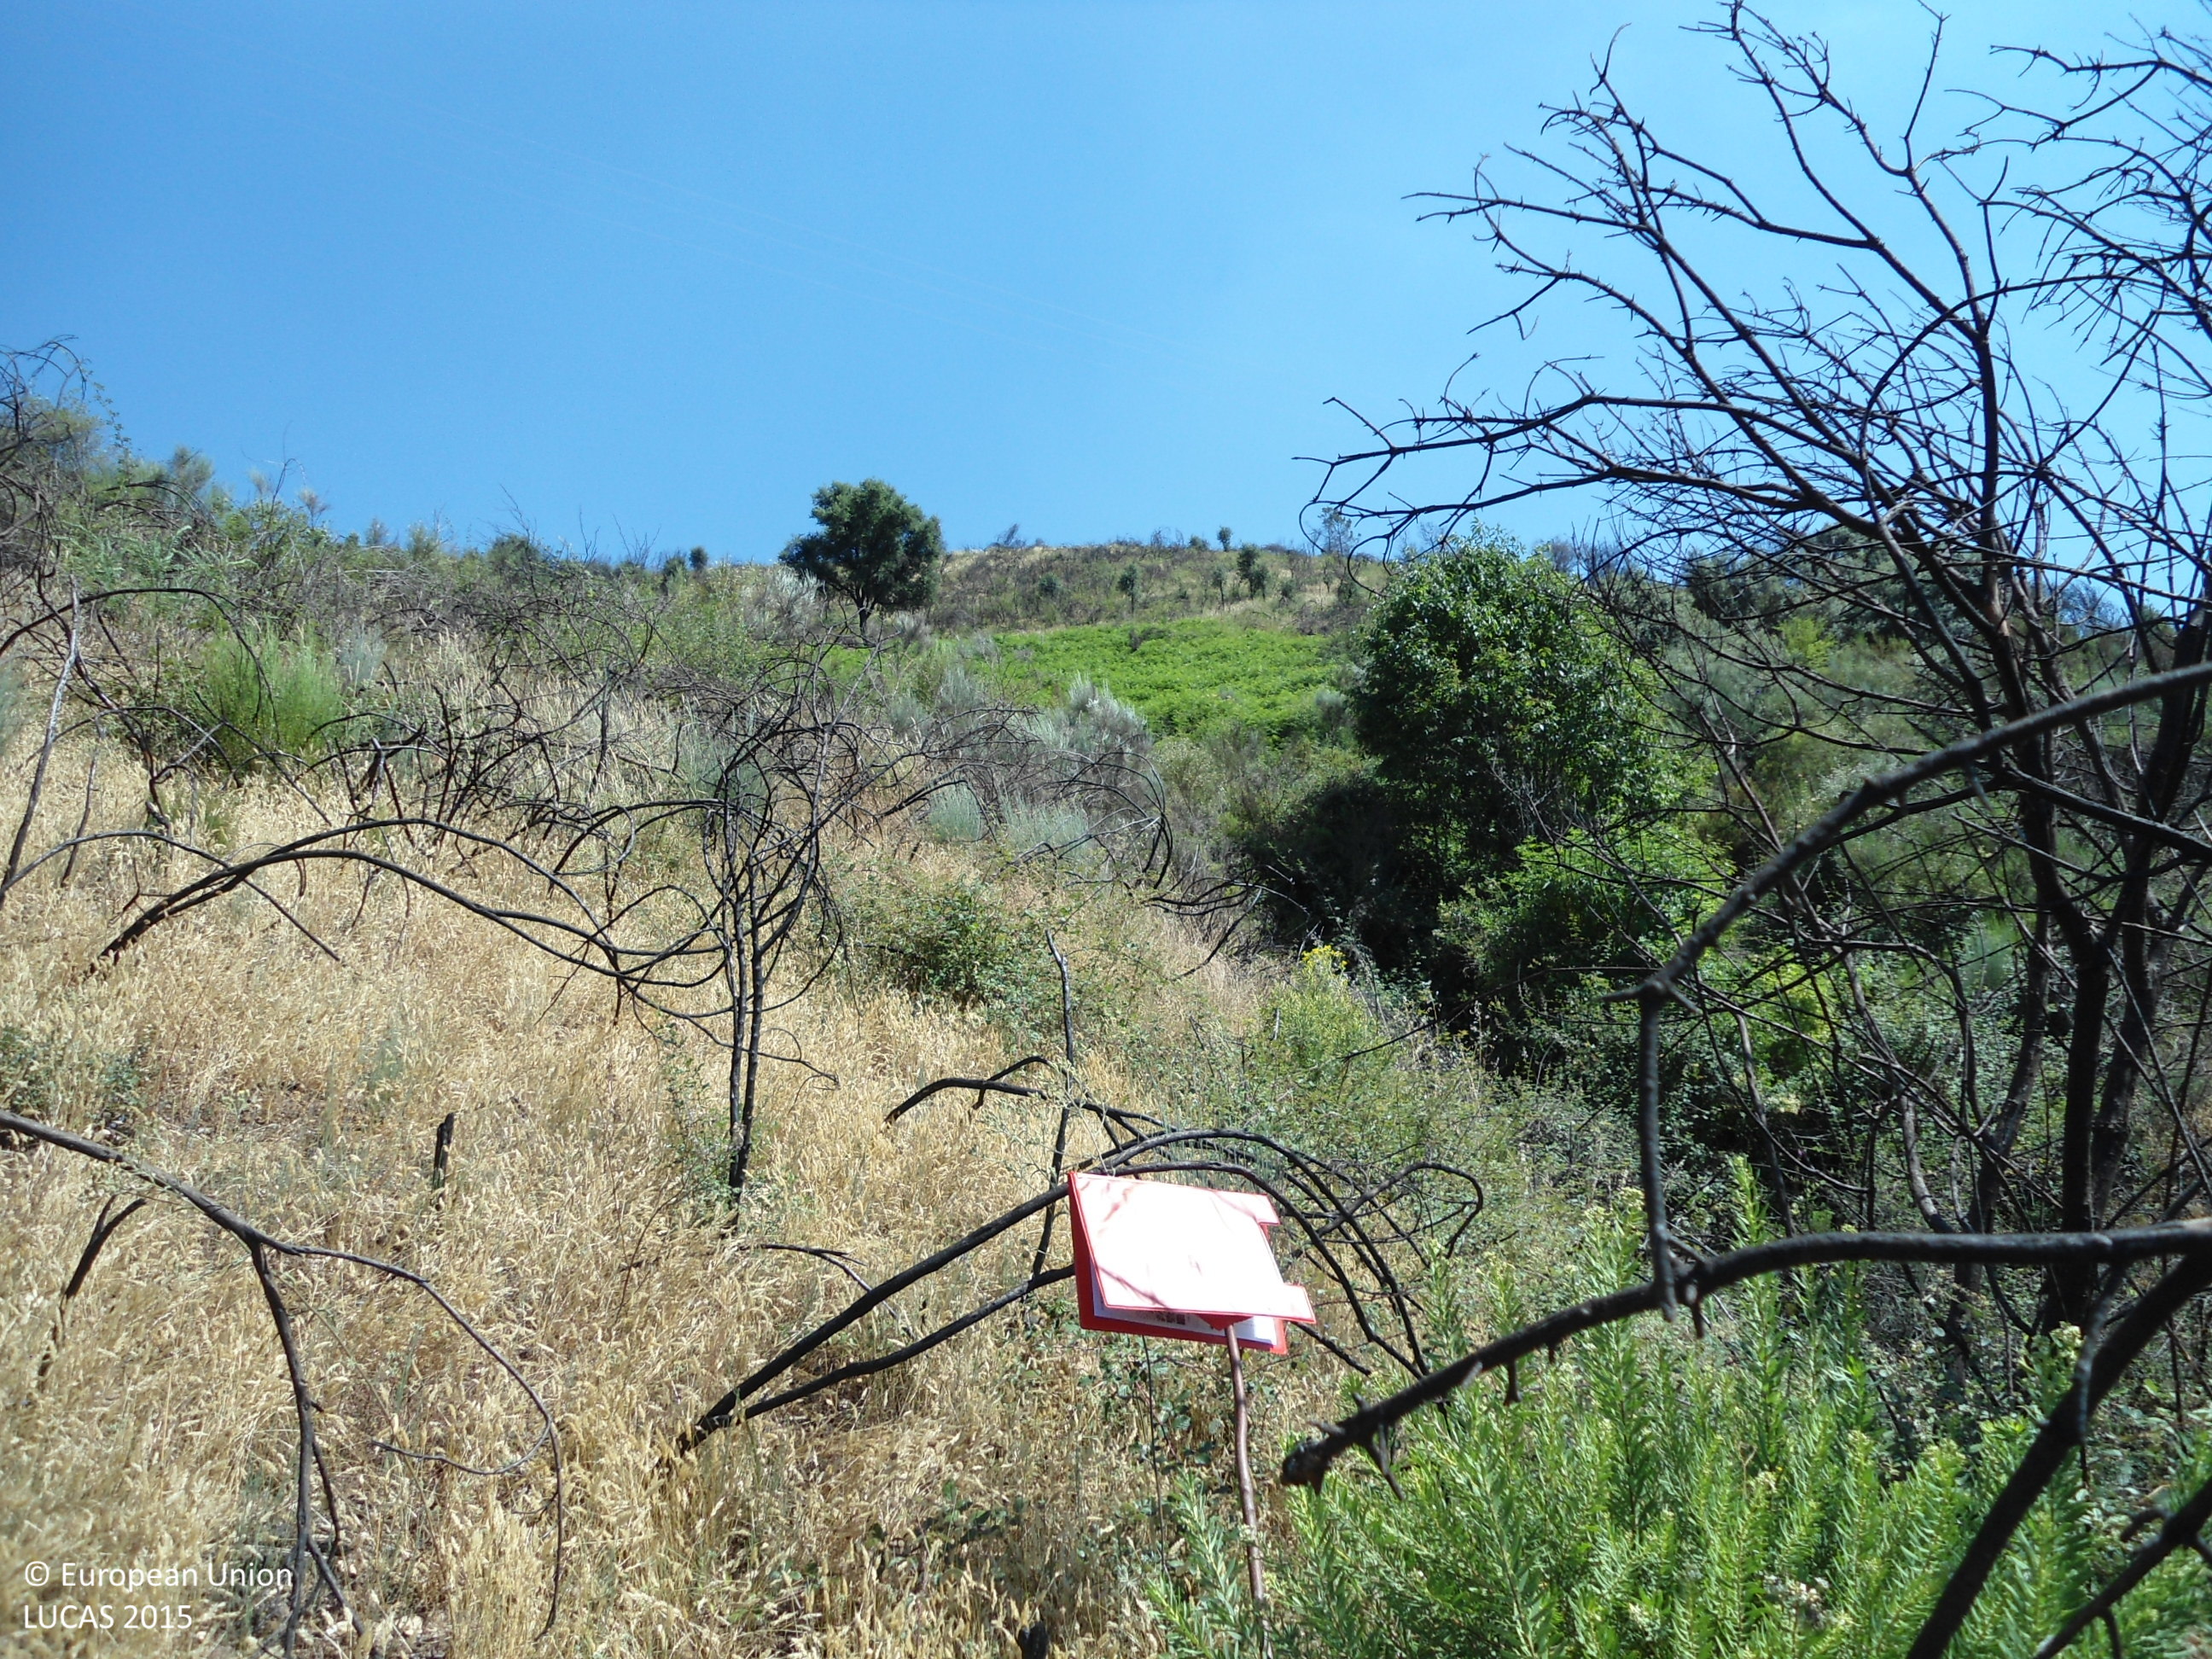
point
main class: Shrubland
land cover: Shrubland with sparse tree cover
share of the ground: 50 - 75 %
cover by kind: shrubs 60 %, herbaceous plants 35 %, broadleaved forest trees 5 %
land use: Semi-natural and natural areas not in use
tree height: > 5 m
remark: Burnt area
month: June
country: ES
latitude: 42.4562
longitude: -6.8944
